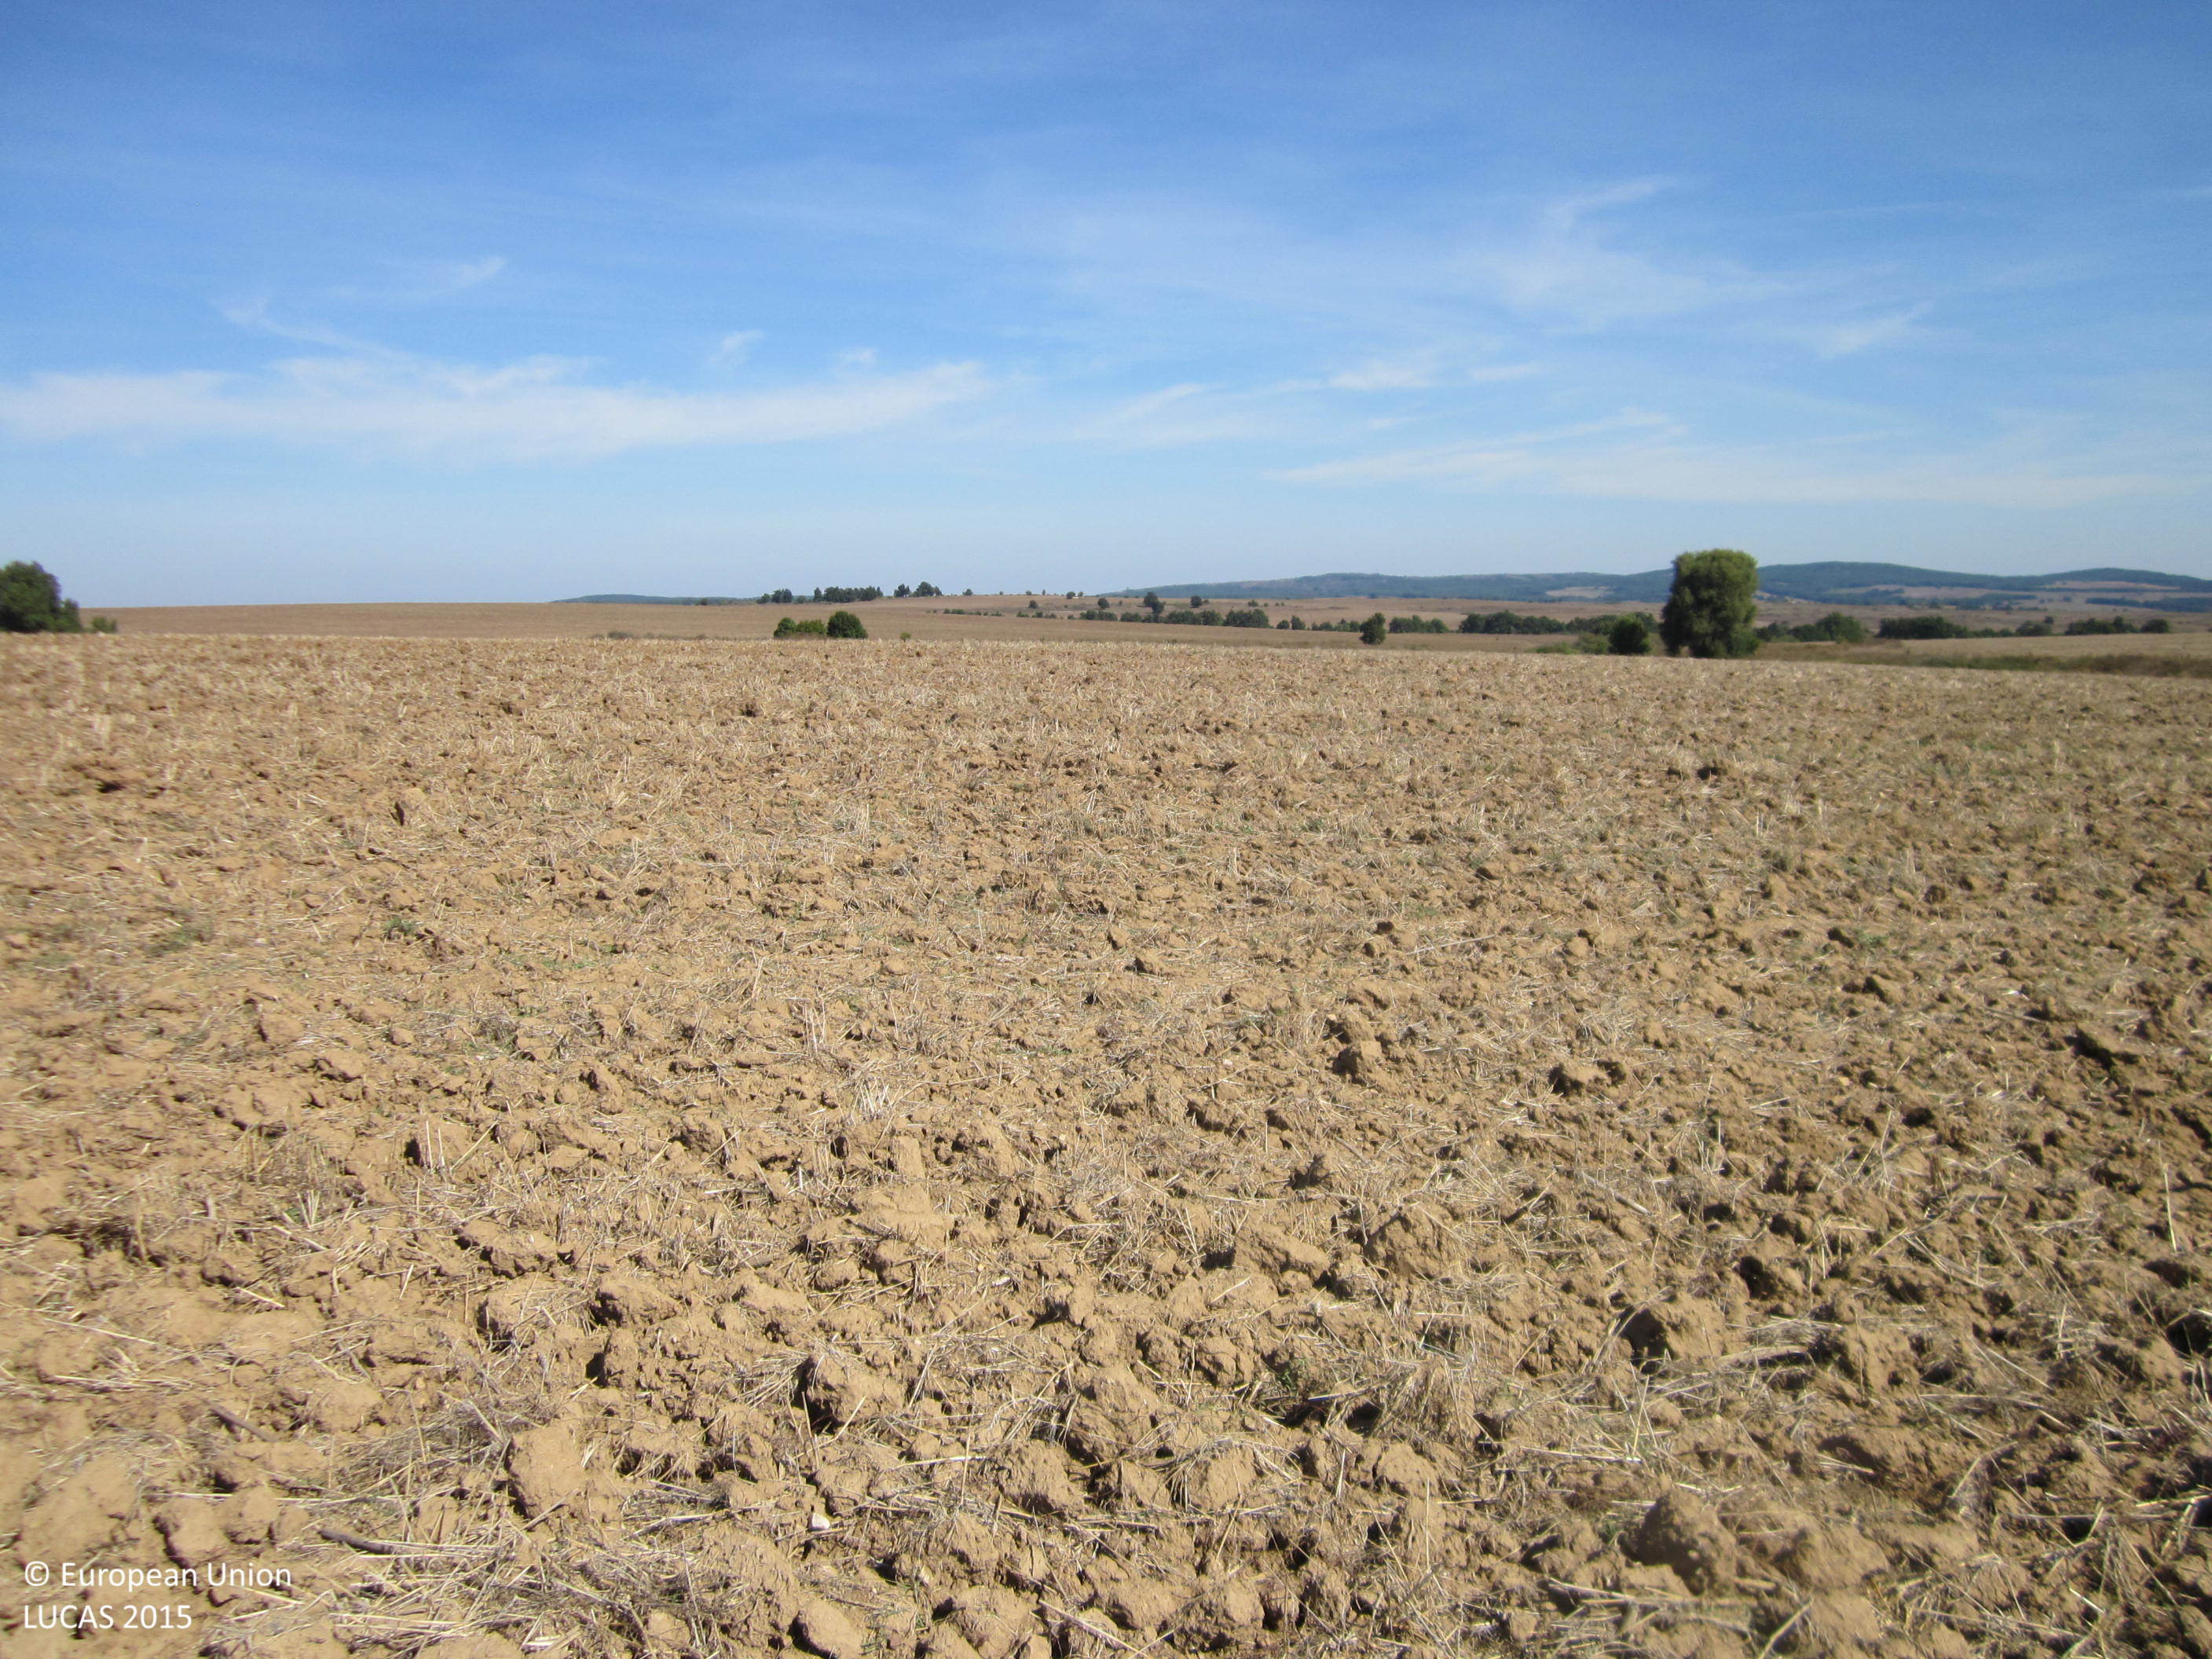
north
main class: Cropland
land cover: Common wheat
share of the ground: < 10 %
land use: Agriculture (excluding fallow land and kitchen gardens)
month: September
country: BG
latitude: 42.1471
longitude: 26.9798
